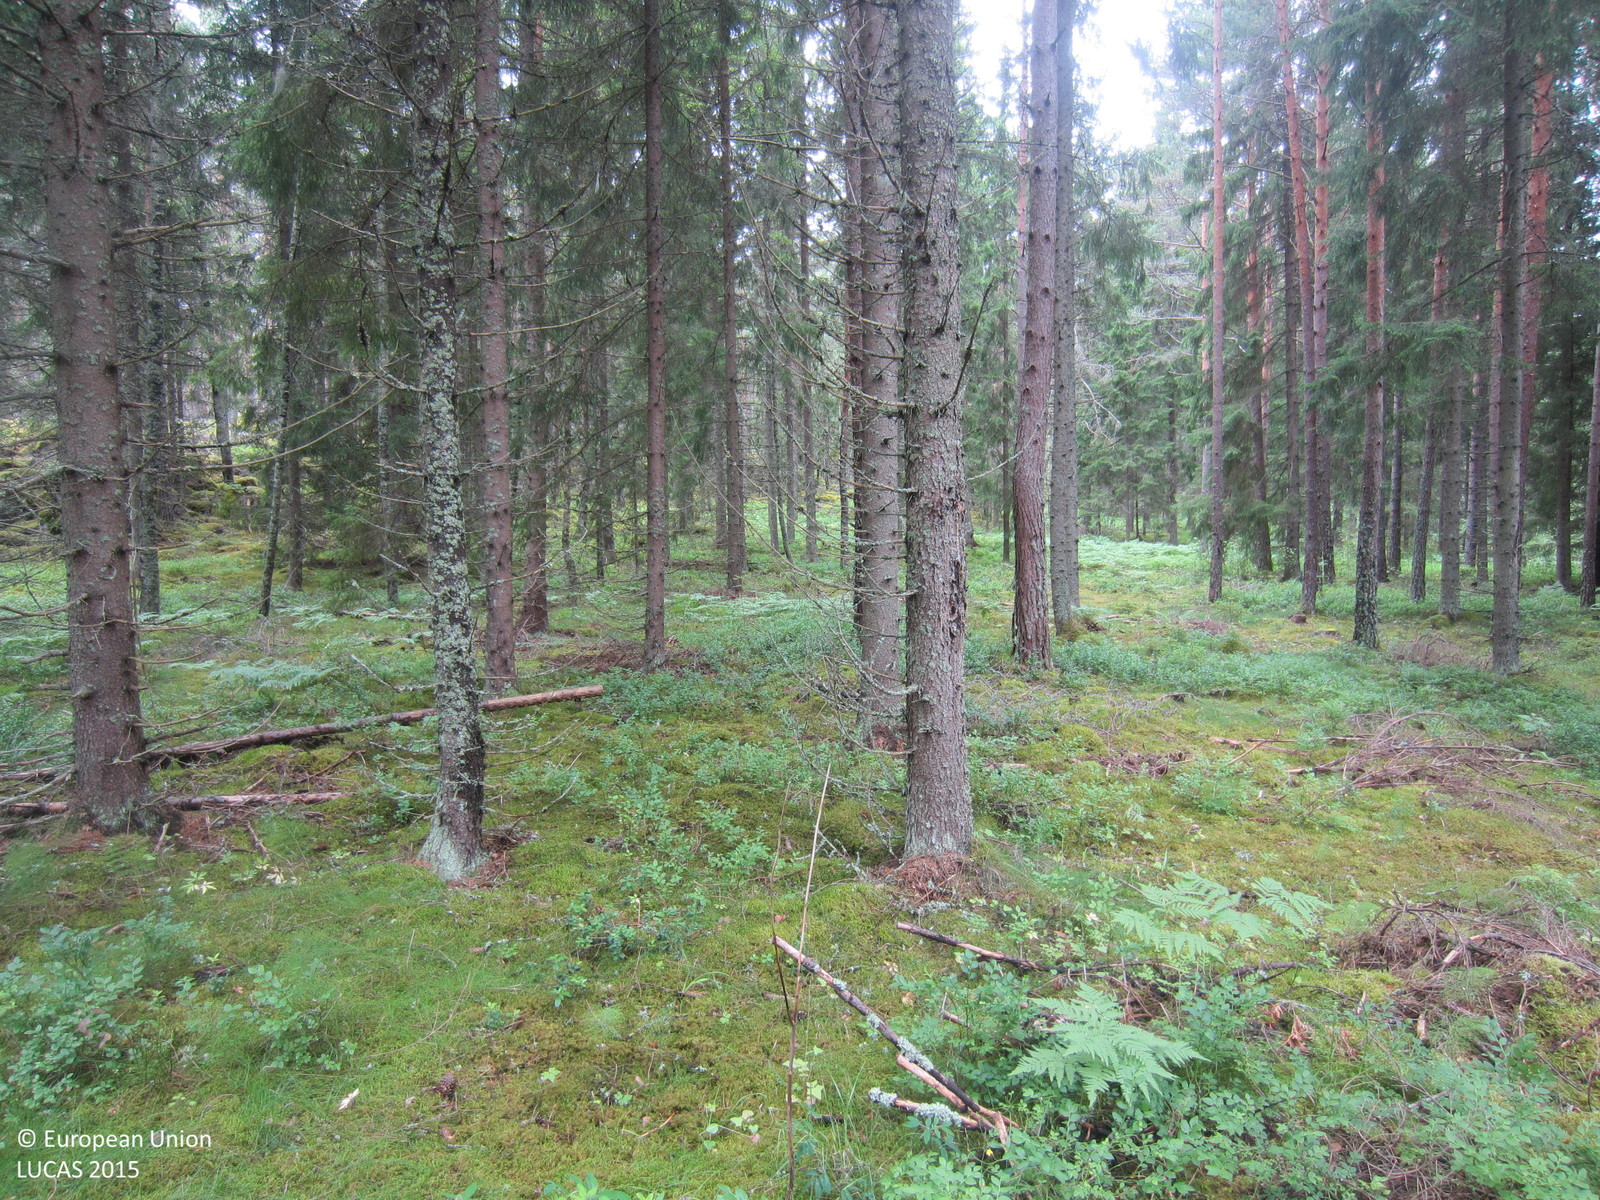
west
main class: Woodland
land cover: Spruce dominated coniferous woodland
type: boreal forest
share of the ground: > 75 %
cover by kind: coniferous forest trees 70 %, herbaceous plants 10 %, lichens and mosses 10 %, broadleaved forest trees 5 %, shrubs 5 %
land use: Forestry
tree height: > 5 m
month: July
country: SE
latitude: 59.8241
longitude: 17.0376
